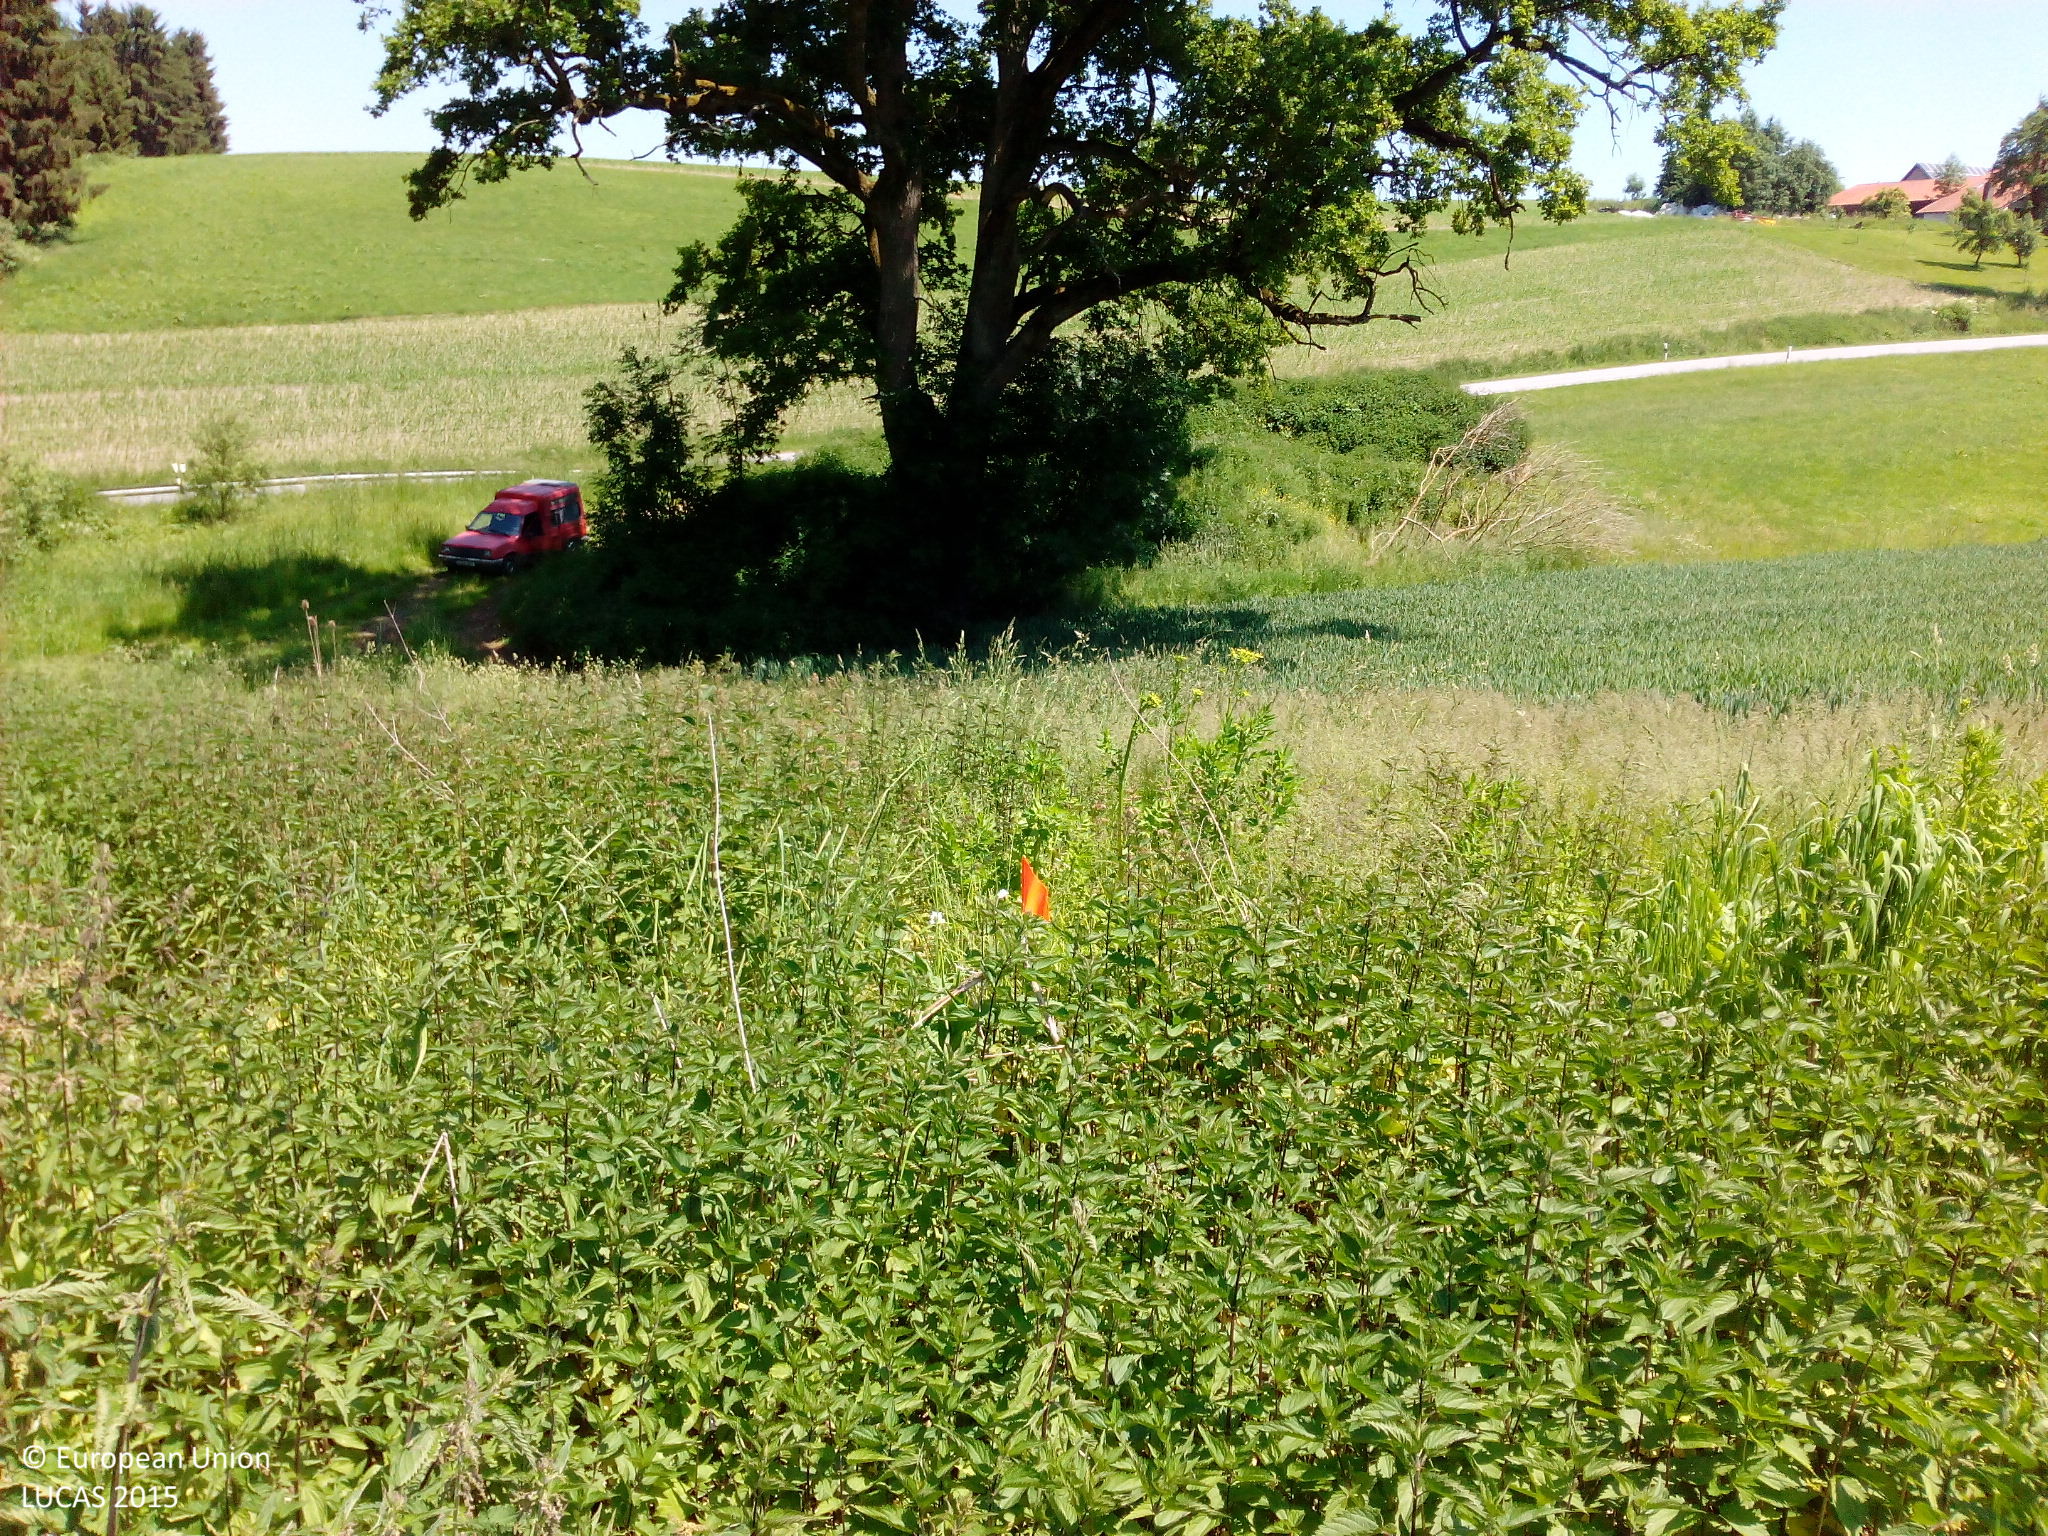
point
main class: Grassland
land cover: Spontaneously vegetated surfaces
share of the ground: > 75 %
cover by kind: herbaceous plants 95 %, shrubs 5 %
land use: Fallow land
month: June
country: DE
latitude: 48.7031
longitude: 12.3228
